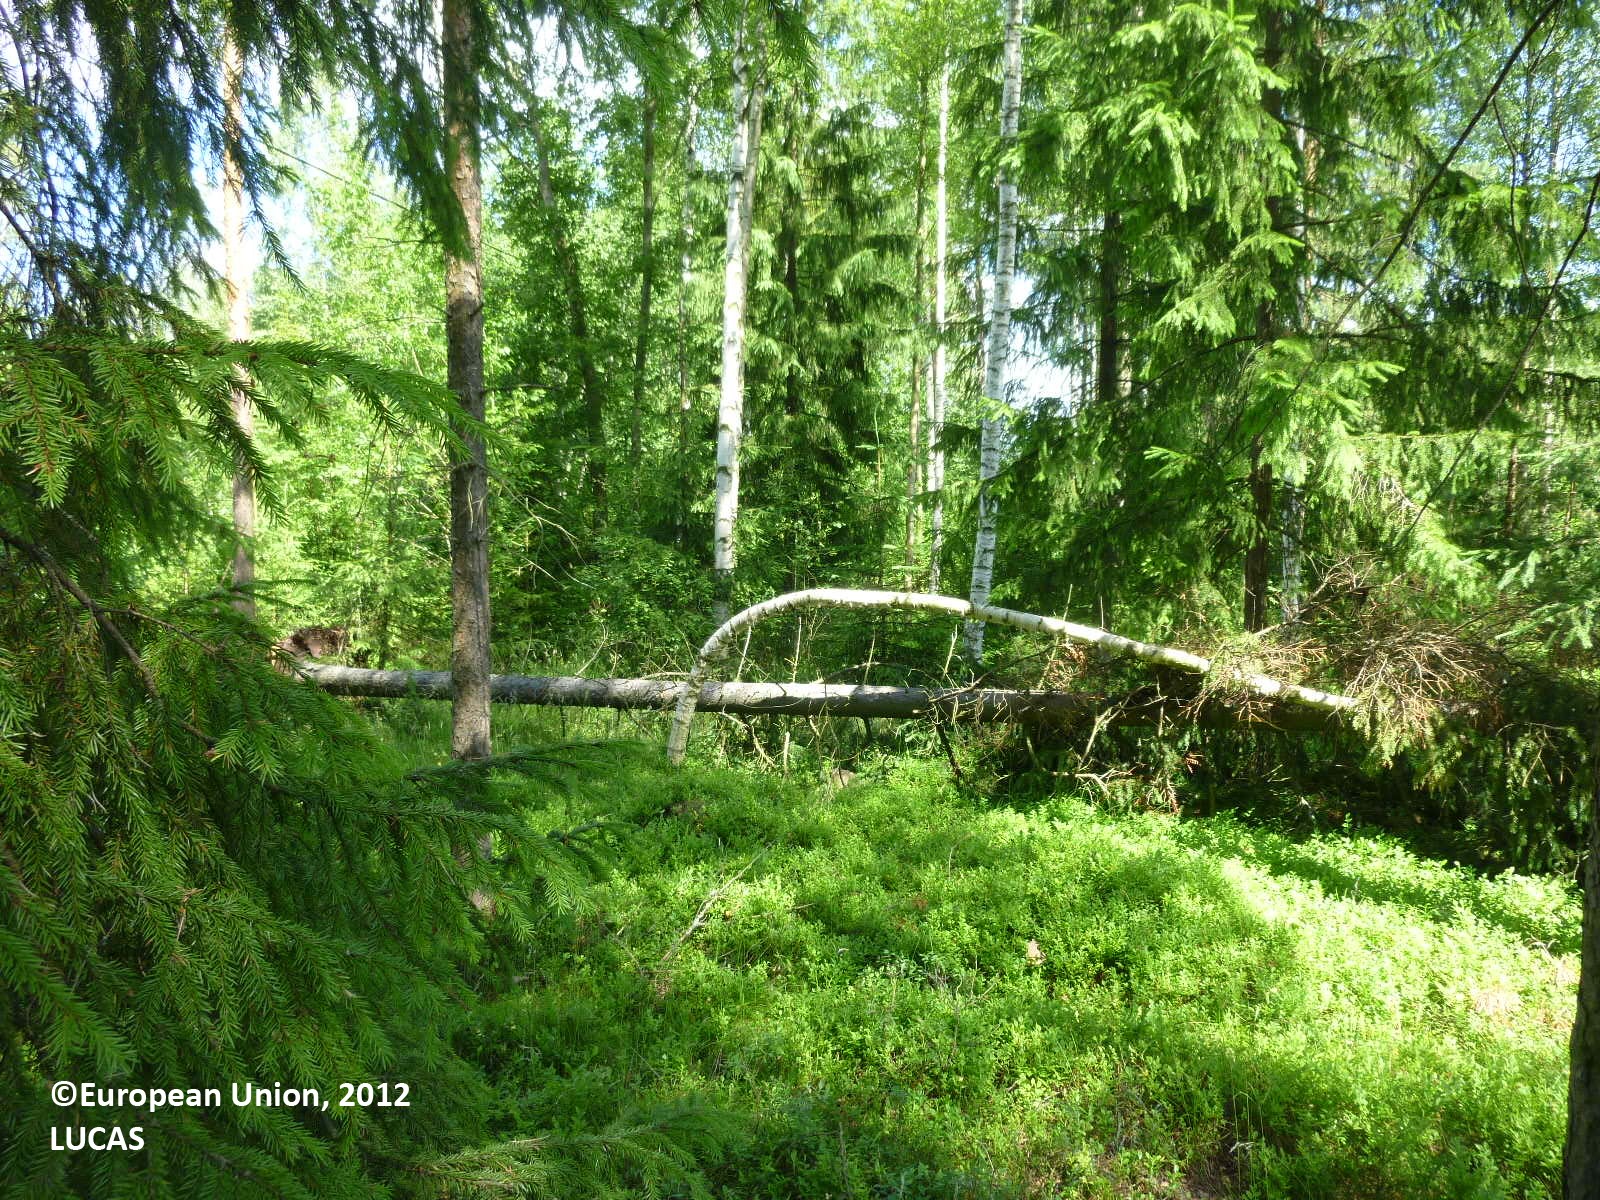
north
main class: Woodland
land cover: Other coniferous woodland
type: boreal forest
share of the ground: > 75 %
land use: Forestry
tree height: > 5 m
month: July
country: FI
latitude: 61.3533
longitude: 22.1199
